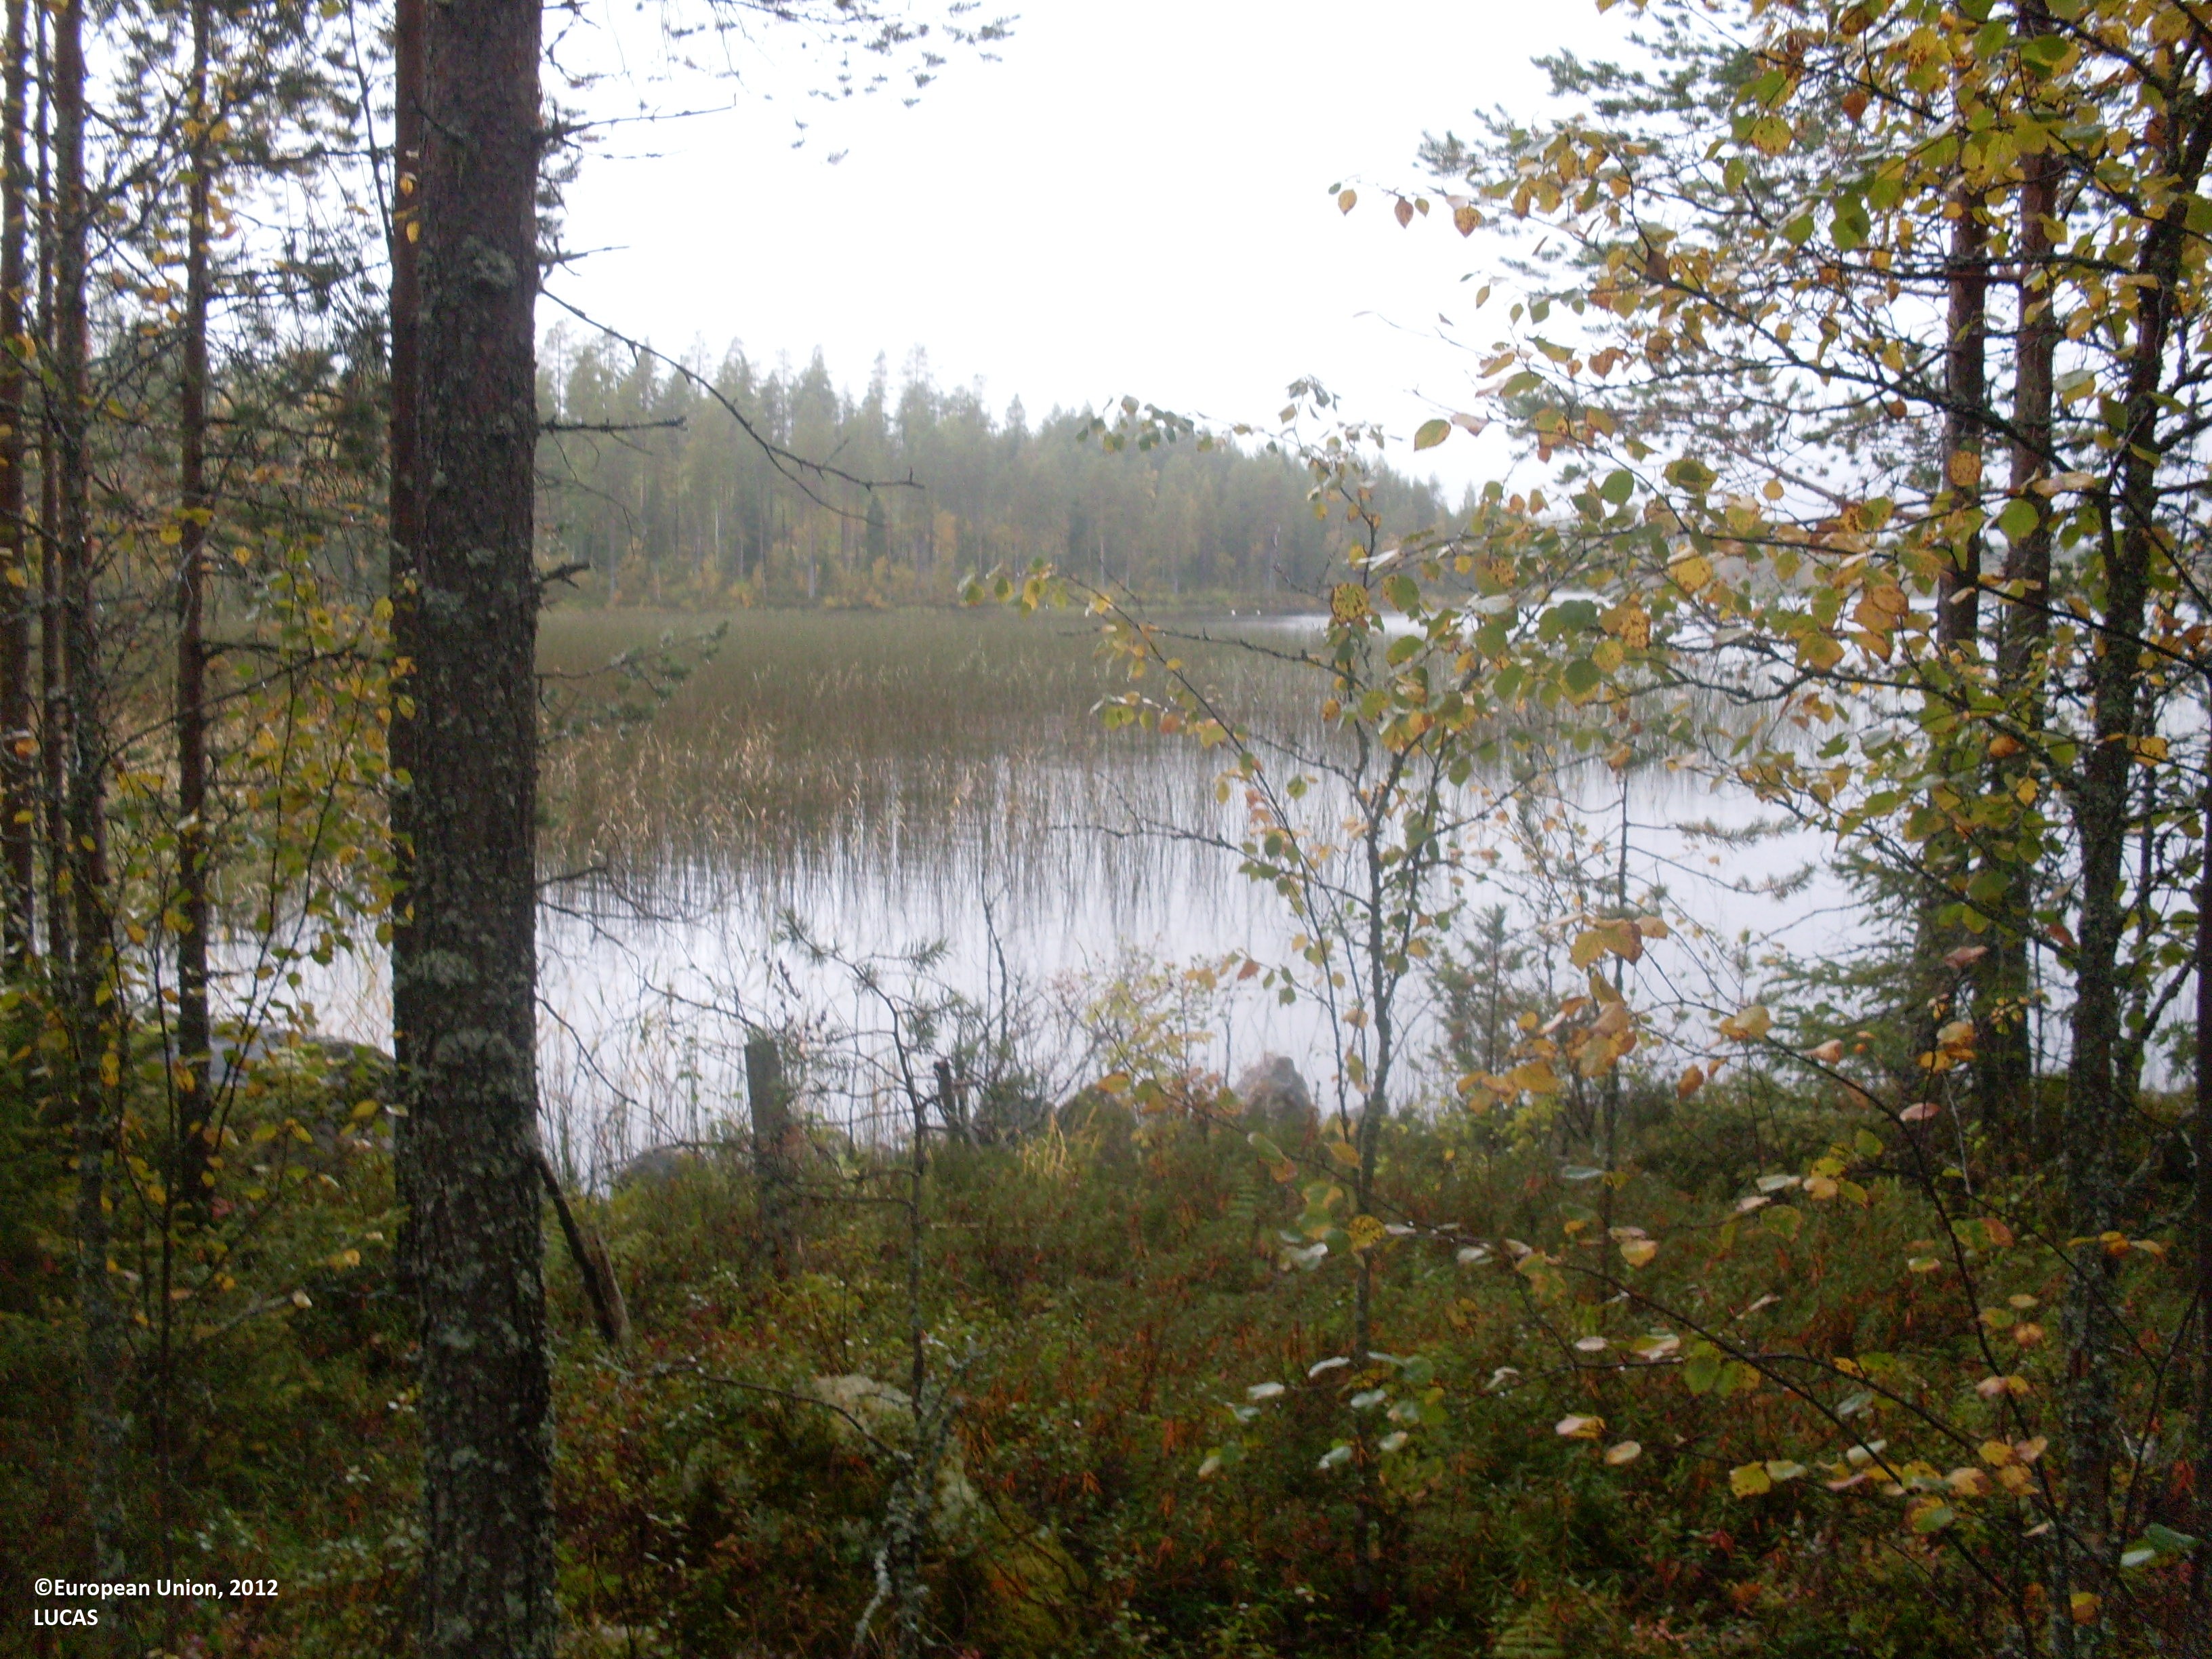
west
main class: Woodland
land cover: Pine dominated mixed woodland
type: boreal forest
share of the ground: > 75 %
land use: Forestry
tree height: > 5 m
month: September
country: FI
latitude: 64.0150
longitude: 30.1946
